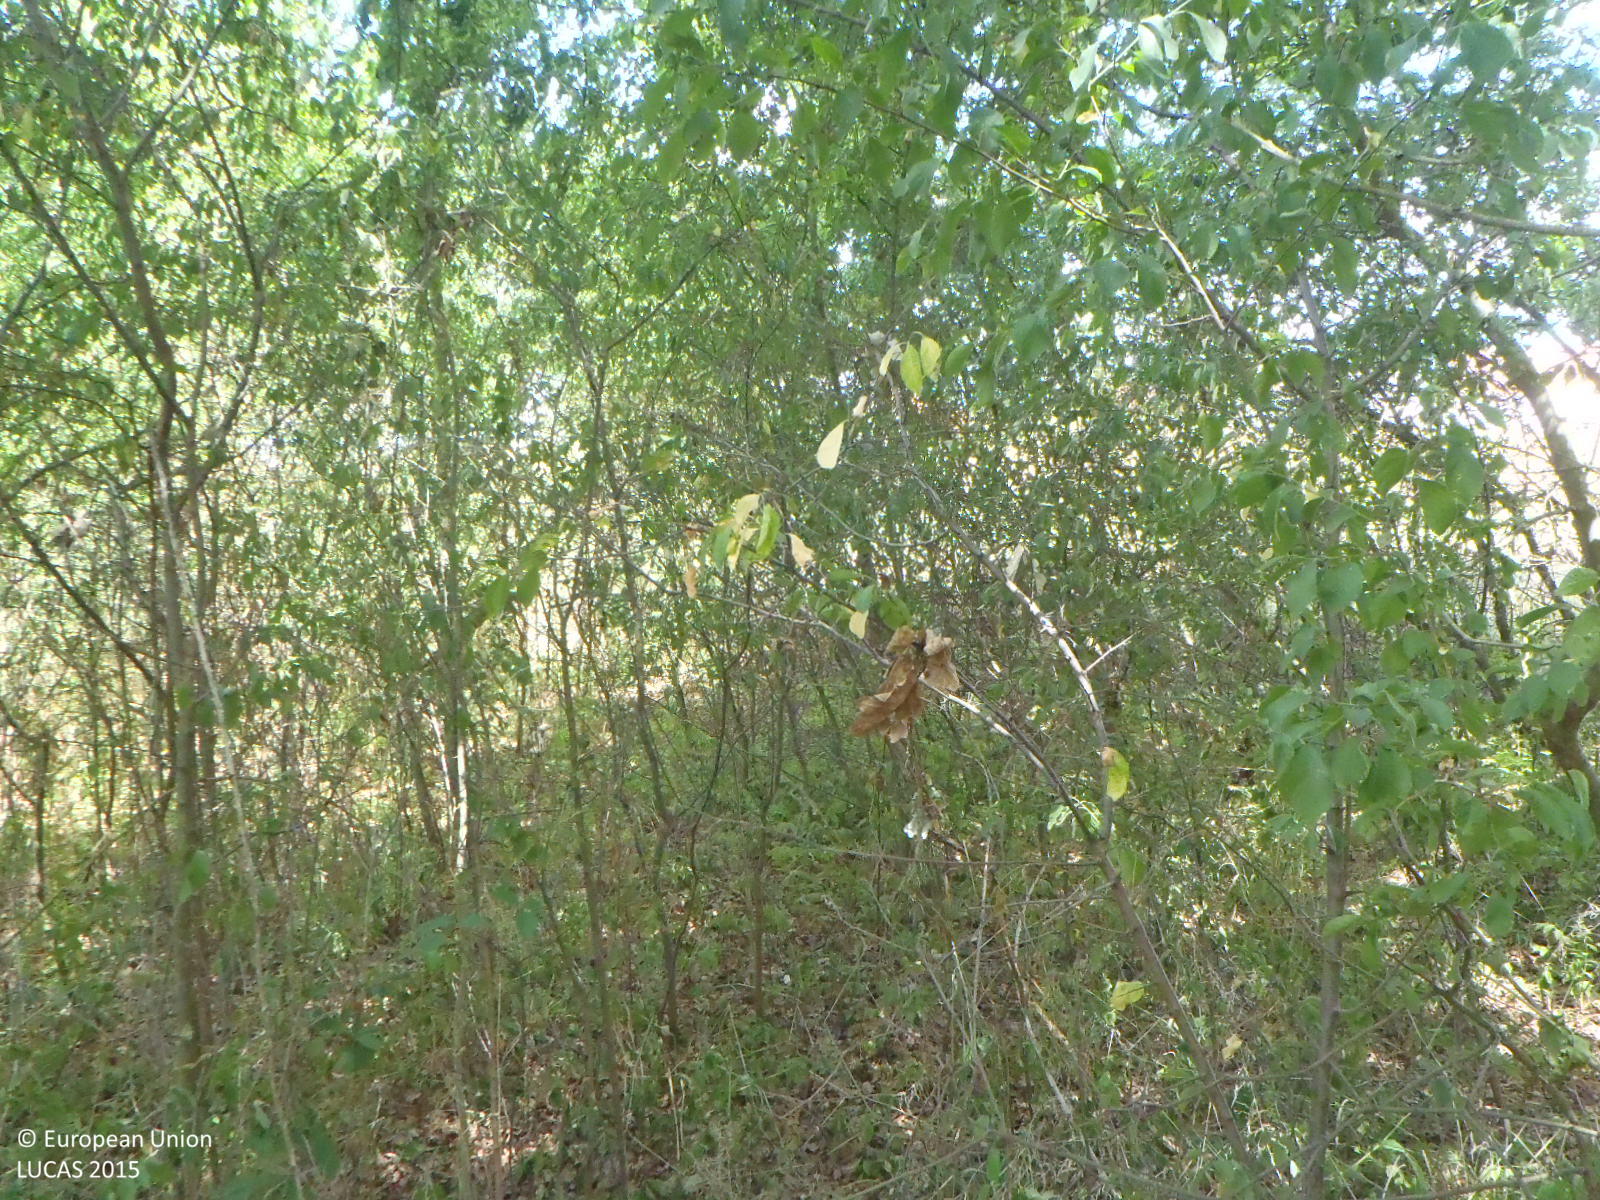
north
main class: Woodland
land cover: Broadleaved woodland
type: mesophytic deciduous forest
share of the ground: > 75 %
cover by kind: broadleaved forest trees 95 %, shrubs 5 %
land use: Forestry
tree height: > 5 m
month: July
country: CZ
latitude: 49.0337
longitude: 14.4739
